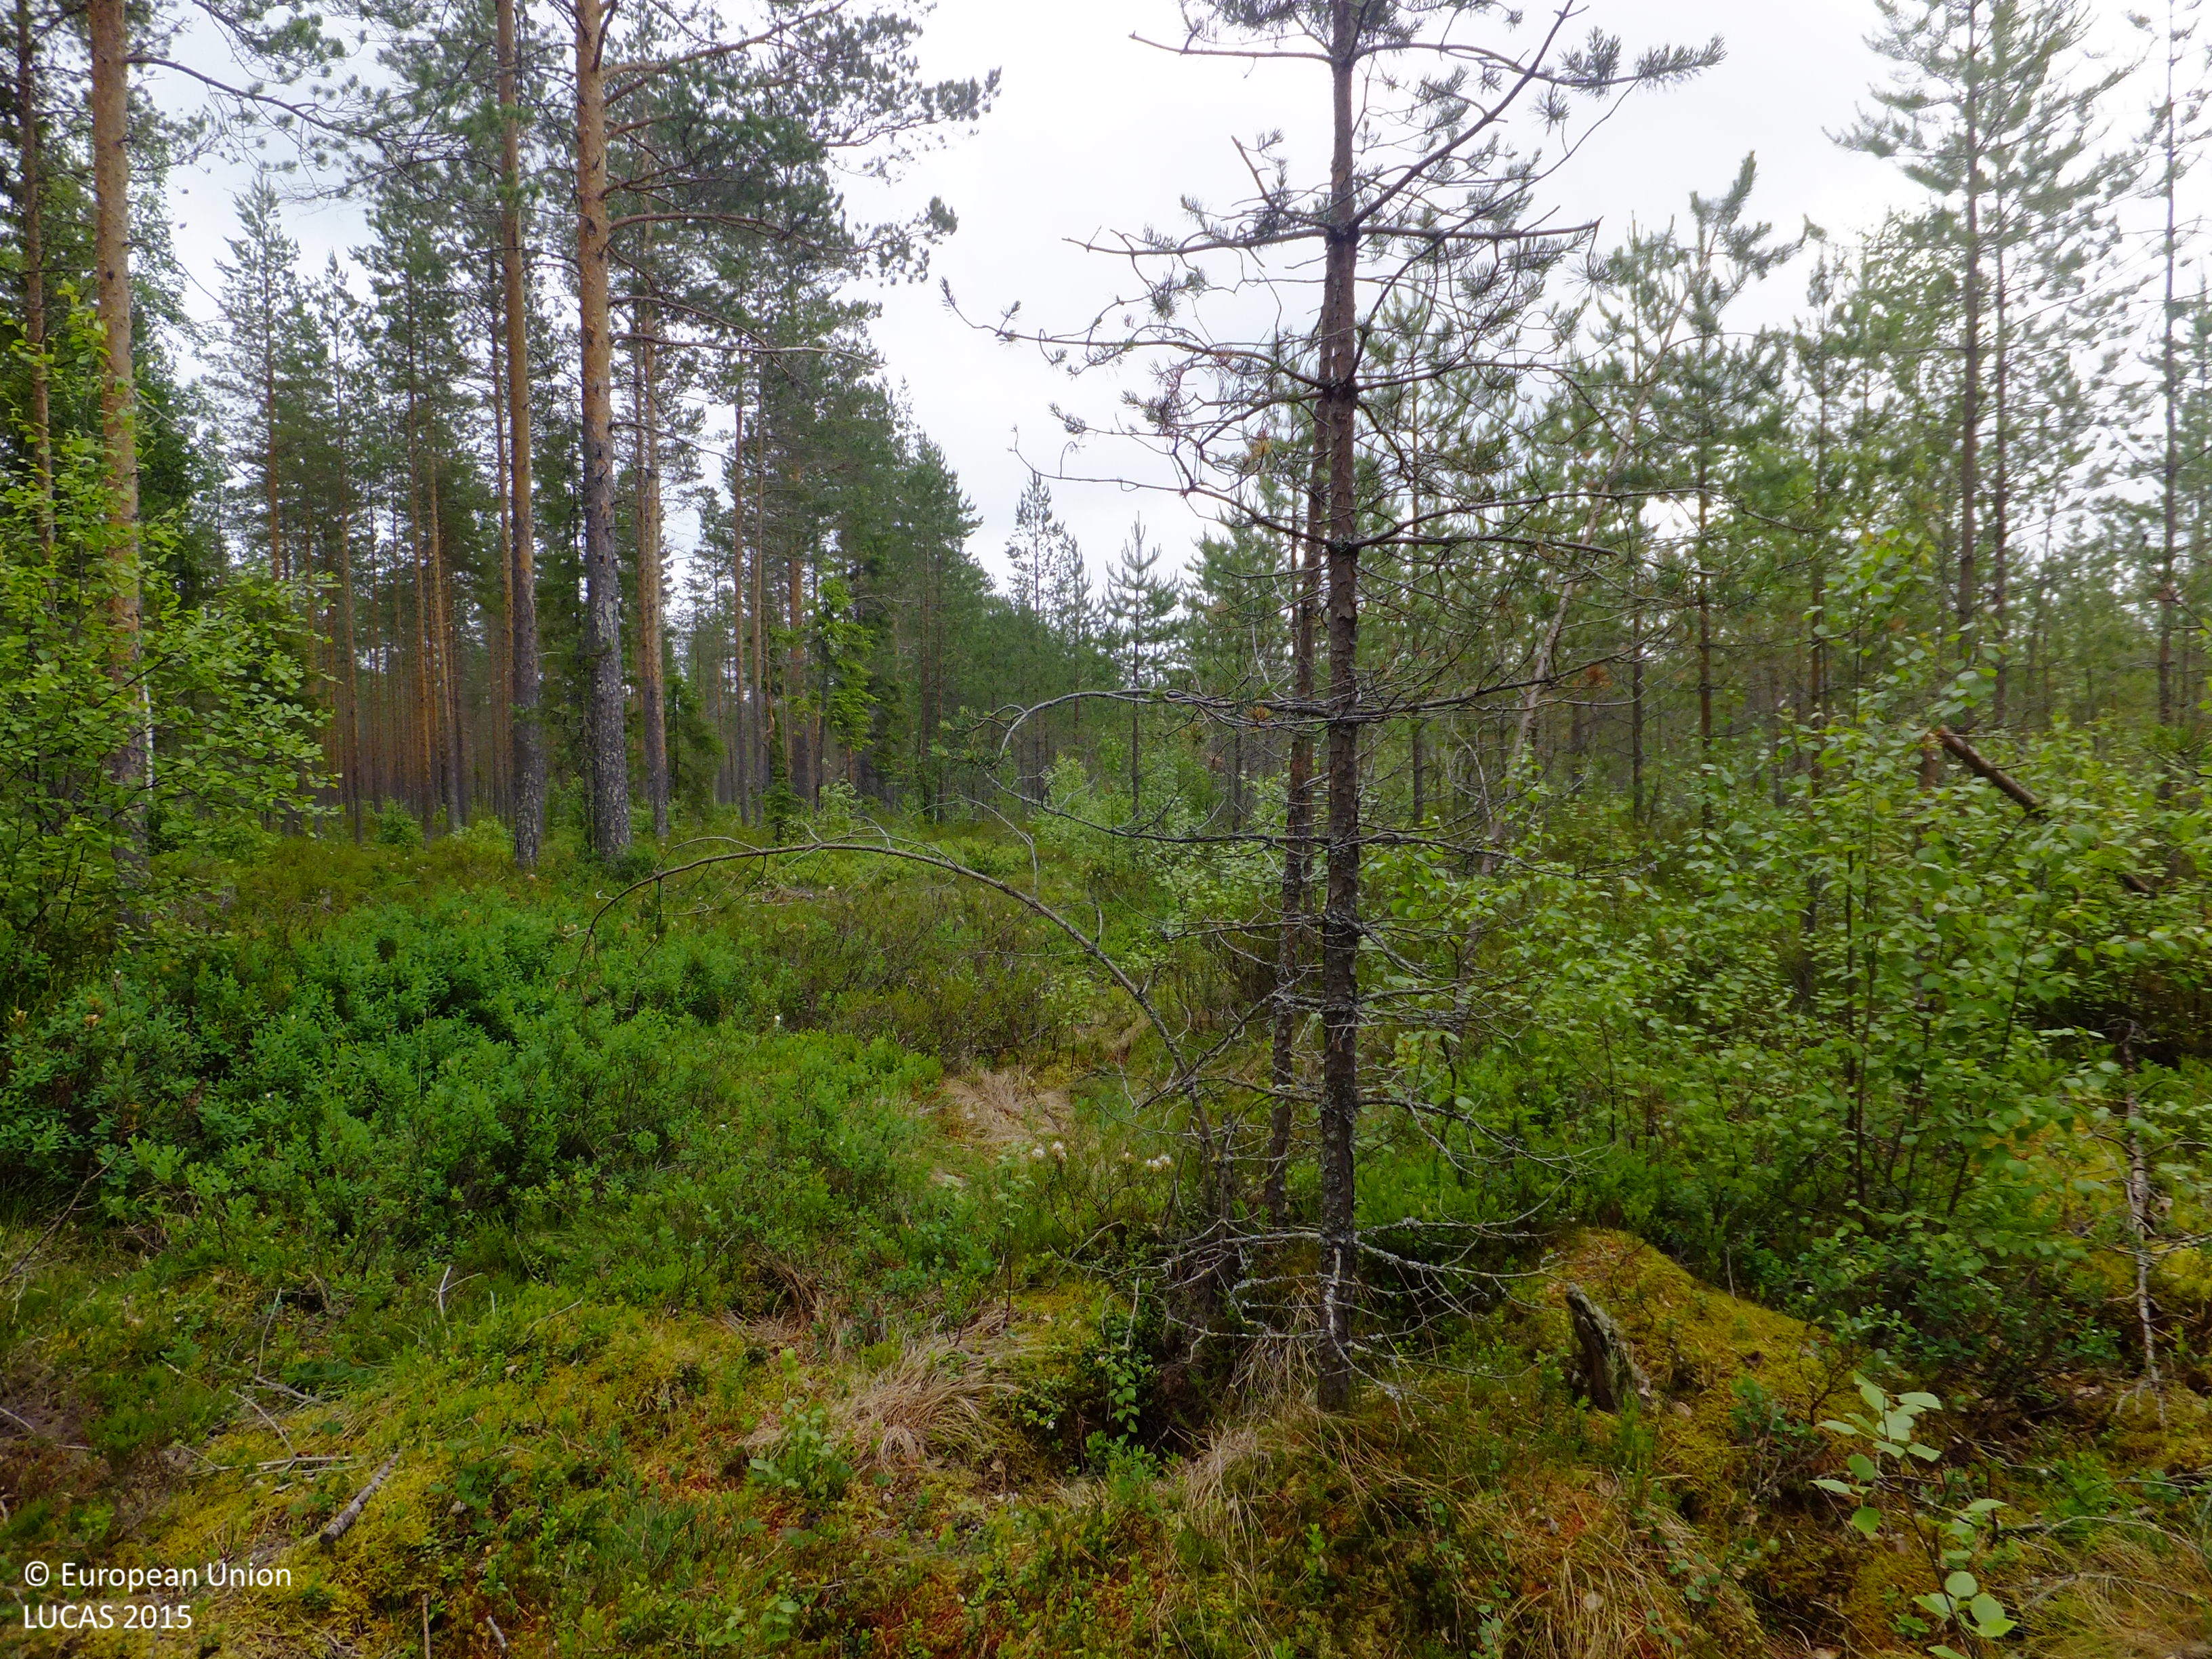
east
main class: Woodland
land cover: Pine dominated mixed woodland
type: boreal forest
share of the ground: 50 - 75 %
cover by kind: coniferous forest trees 40 %, broadleaved forest trees 20 %, shrubs 20 %, lichens and mosses 15 %, herbaceous plants 5 %
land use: Forestry
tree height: > 5 m
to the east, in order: Pine dominated mixed woodland; Pine dominated coniferous woodland; Ditches and canals; Pine dominated coniferous woodland; Ditches and canals; Pine dominated coniferous woodland; Ditches and canals; Pine dominated coniferous woodland; Ditches and canals; Pine dominated coniferous woodland
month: July
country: FI
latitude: 63.1050
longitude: 24.6509
